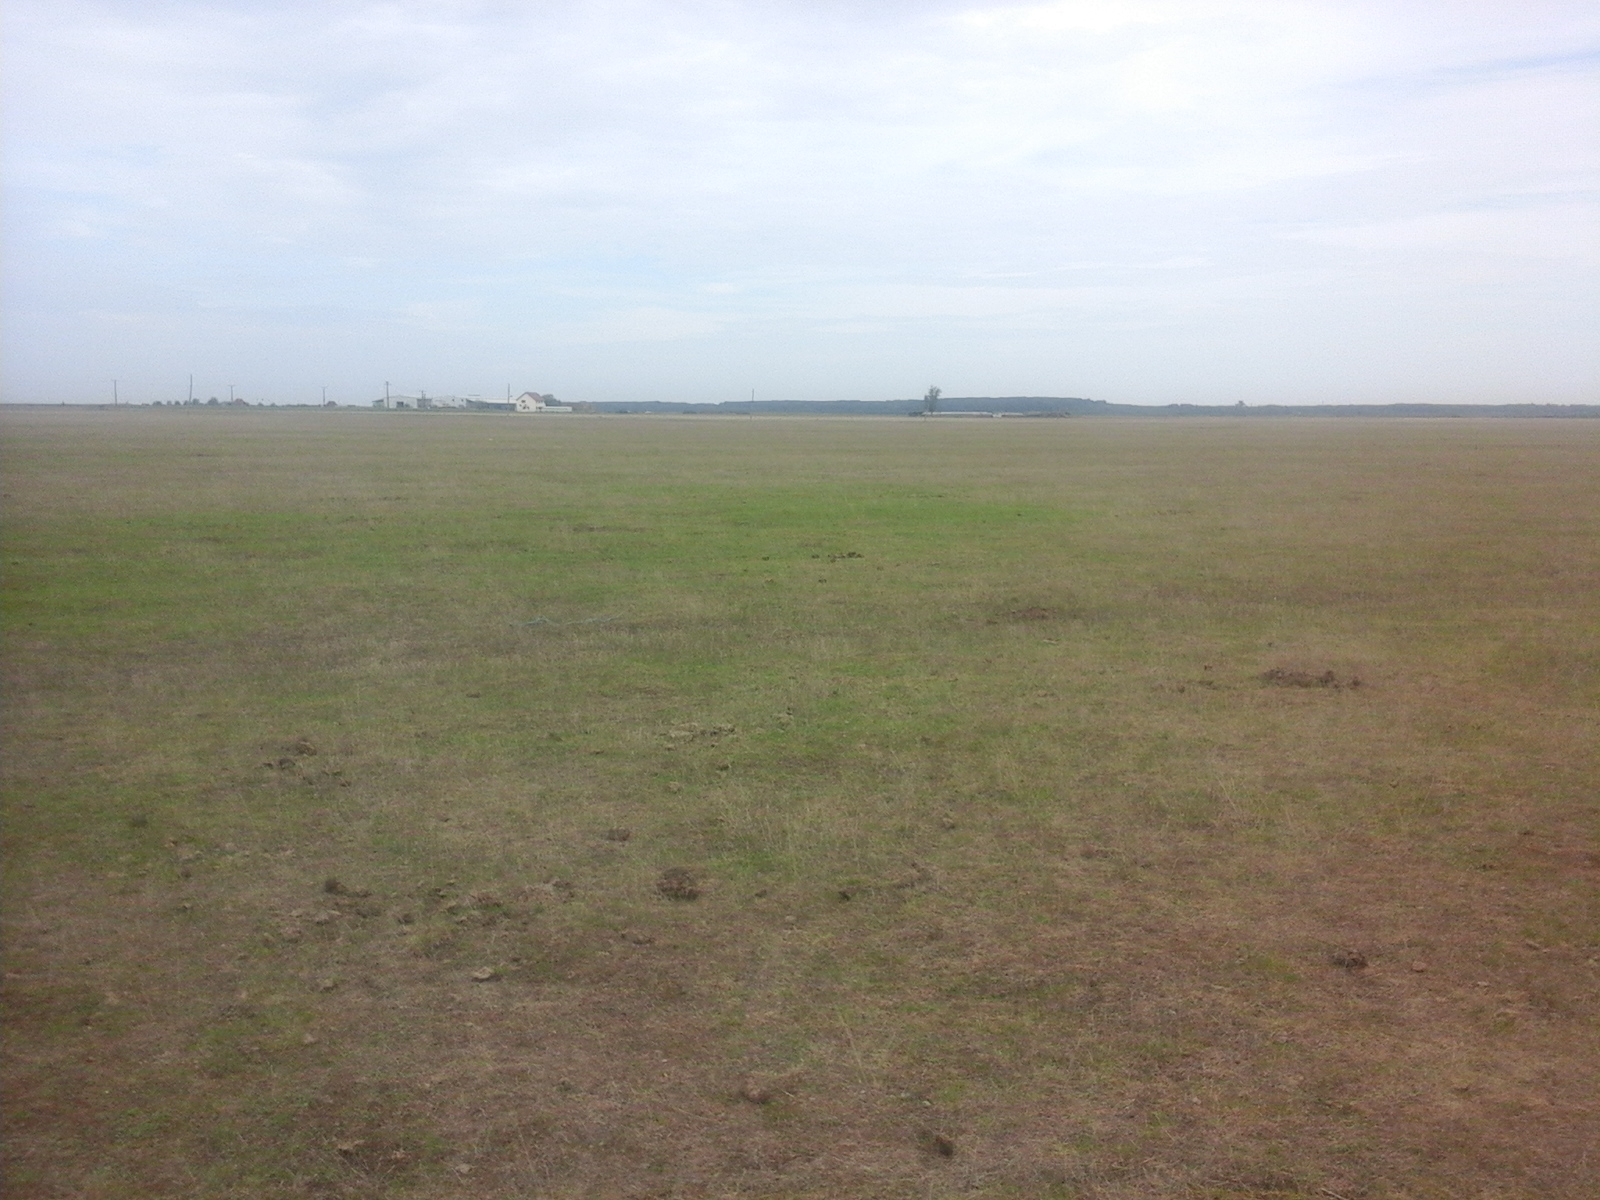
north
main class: Grassland
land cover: Grassland without tree/shrub cover
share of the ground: > 75 %
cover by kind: herbaceous plants 100 %
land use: Agriculture (excluding fallow land and kitchen gardens)
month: August
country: RO
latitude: 46.5168
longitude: 21.4422
